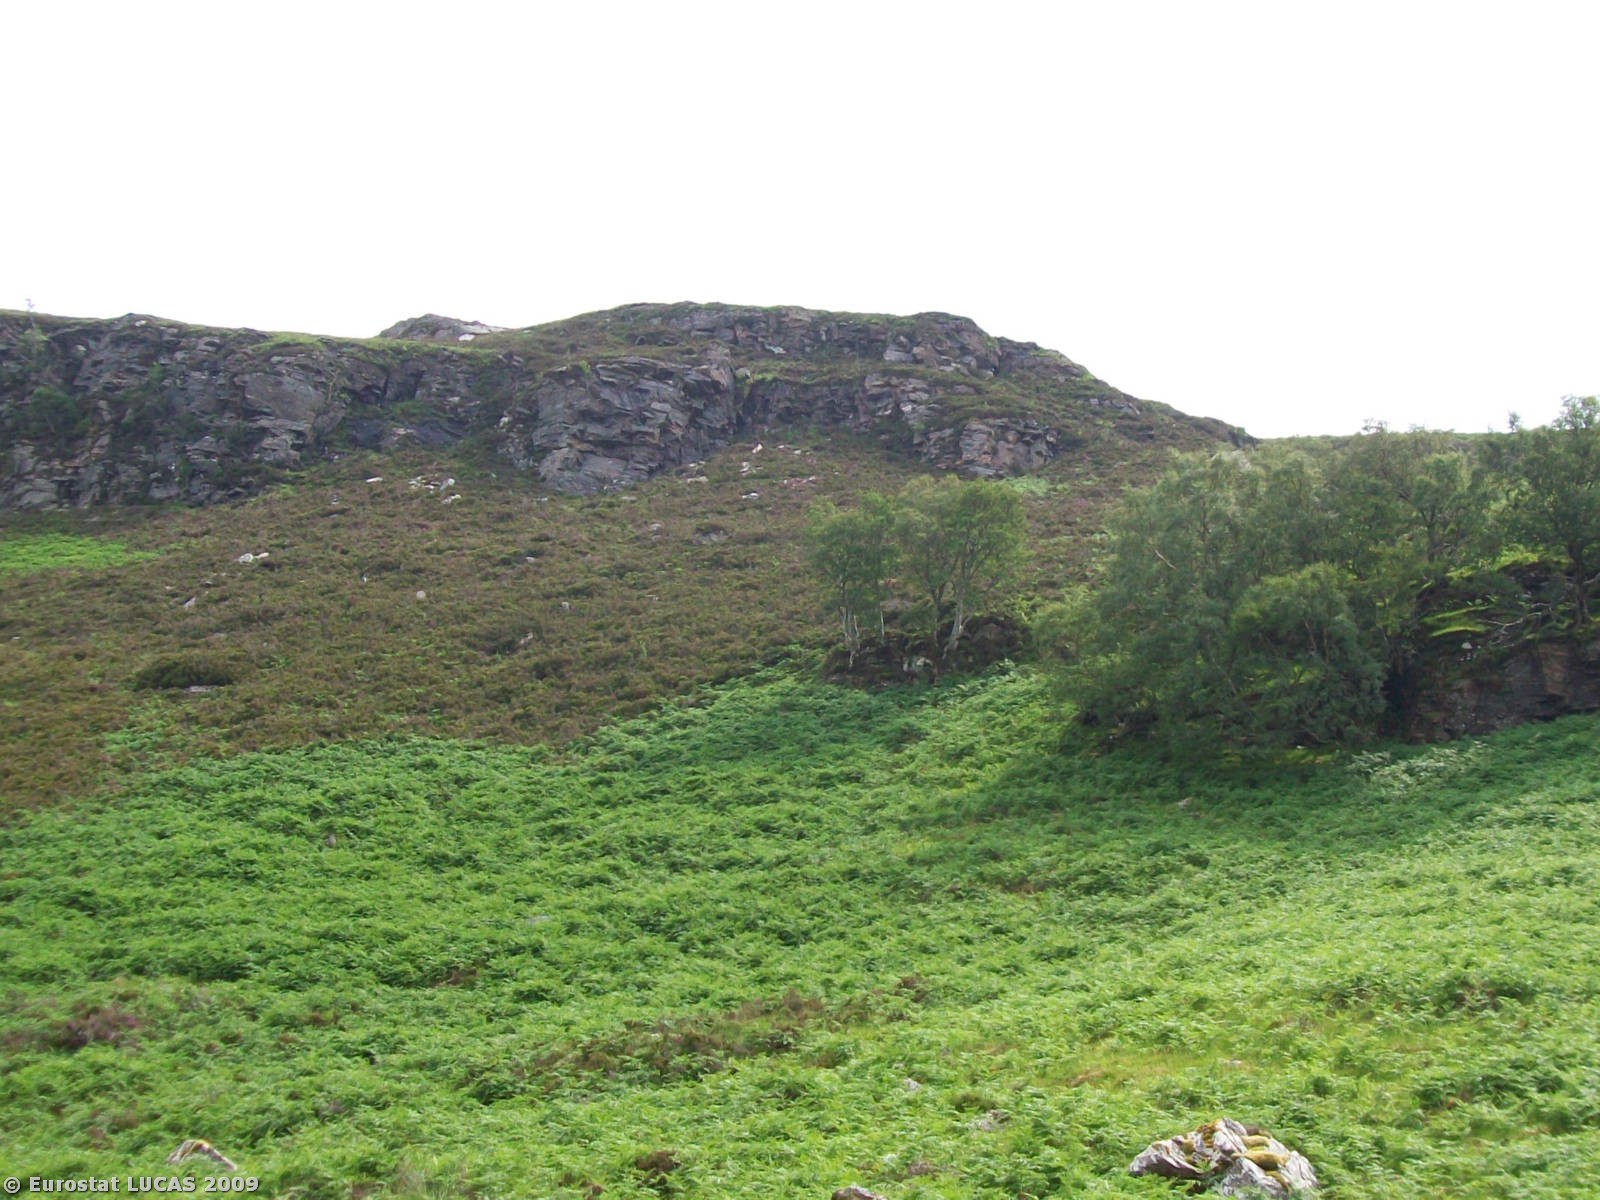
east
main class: Shrubland
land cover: Shrubland without tree cover
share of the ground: > 75 %
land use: Unused
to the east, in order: Shrubland without tree cover; Shrubland with sparse tree cover; Rock outcrops; Shrubland without tree cover; Bare land; Rock outcrops; Shrubland without tree cover; Rock outcrops; Shrubland without tree cover
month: July
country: GB
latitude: 57.7925
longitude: -5.1605
